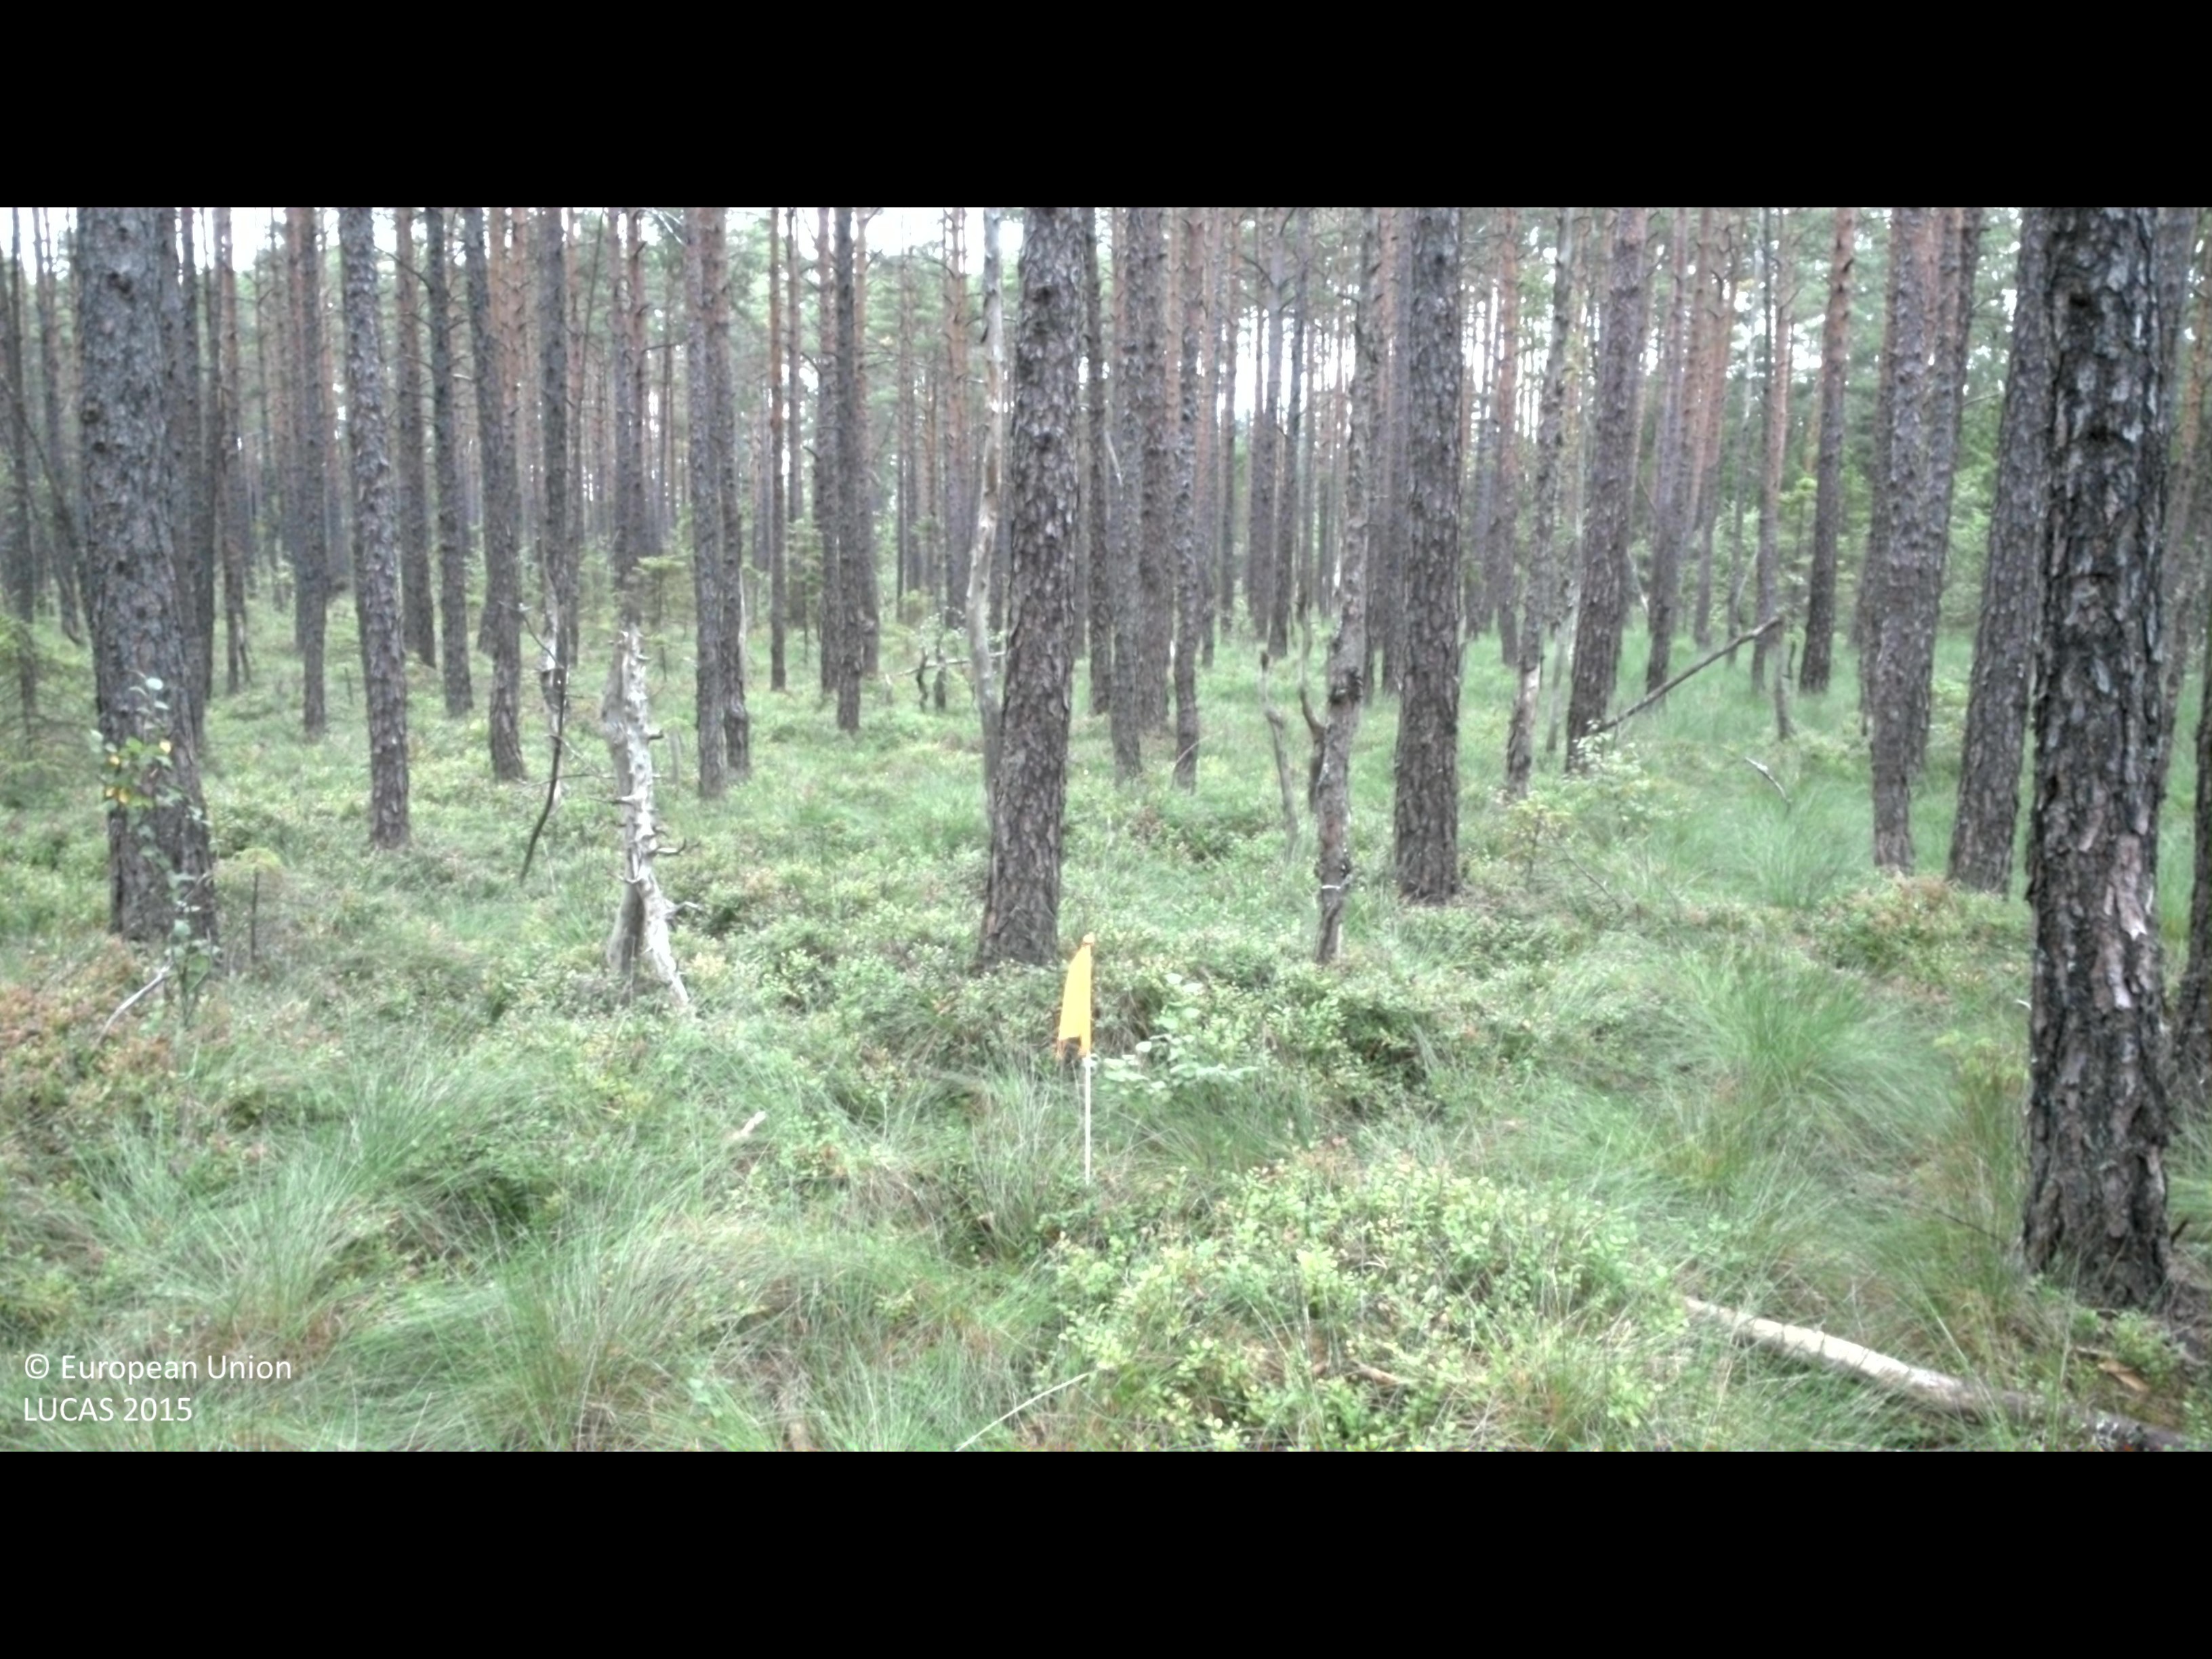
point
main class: Woodland
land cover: Pine dominated coniferous woodland
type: boreal forest
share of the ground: 50 - 75 %
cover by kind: coniferous forest trees 70 %, shrubs 30 %
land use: Forestry
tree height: > 5 m
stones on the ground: < 10 %
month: August
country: SE
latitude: 56.9044
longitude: 13.1657
